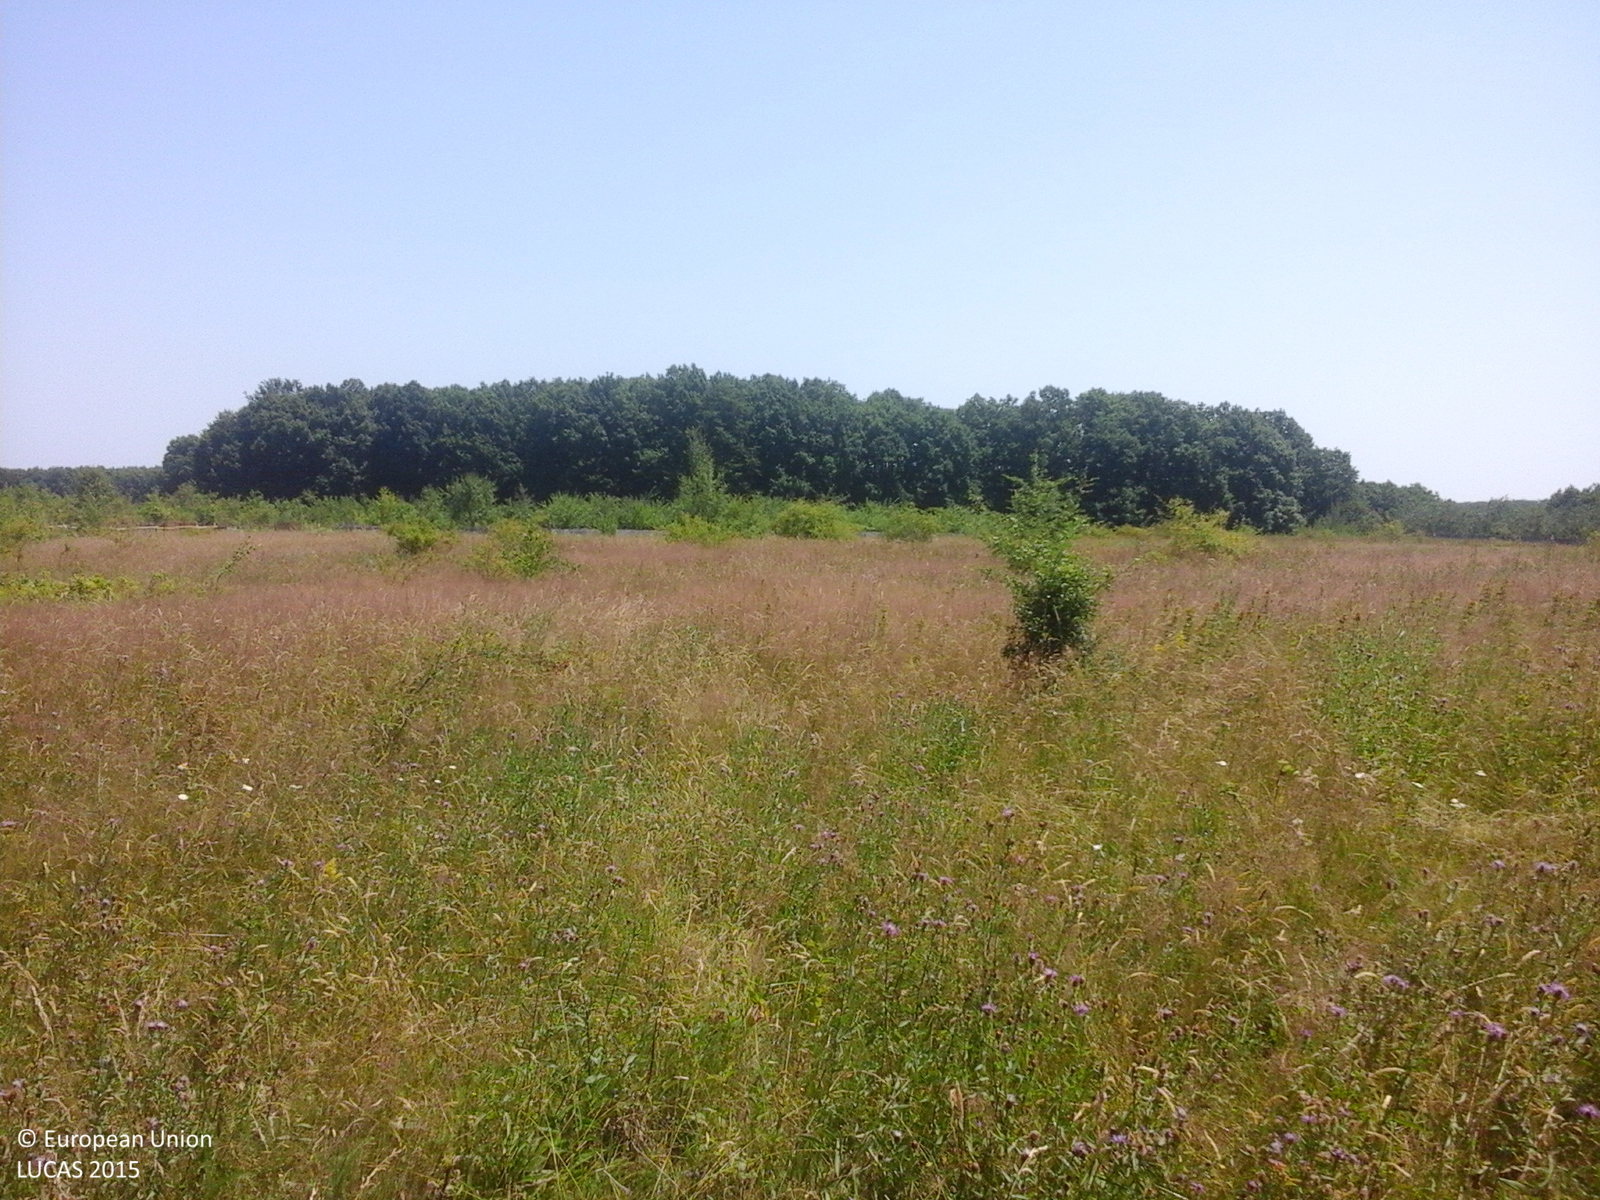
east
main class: Grassland
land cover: Grassland without tree/shrub cover
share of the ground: > 75 %
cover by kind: herbaceous plants 100 %
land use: Agriculture (excluding fallow land and kitchen gardens)
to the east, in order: Grassland without tree/shrub cover; Paved roads, cycling and walking lanes; Grass margins; Fences; Other fruit trees and berries; Fences; Other fruit trees and berries; Fences; Abandoned hedges; Grassland with sparse tree/shrub cover; Fences; Broadleaved woodland
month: July
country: RO
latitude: 45.0505
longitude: 25.1089
